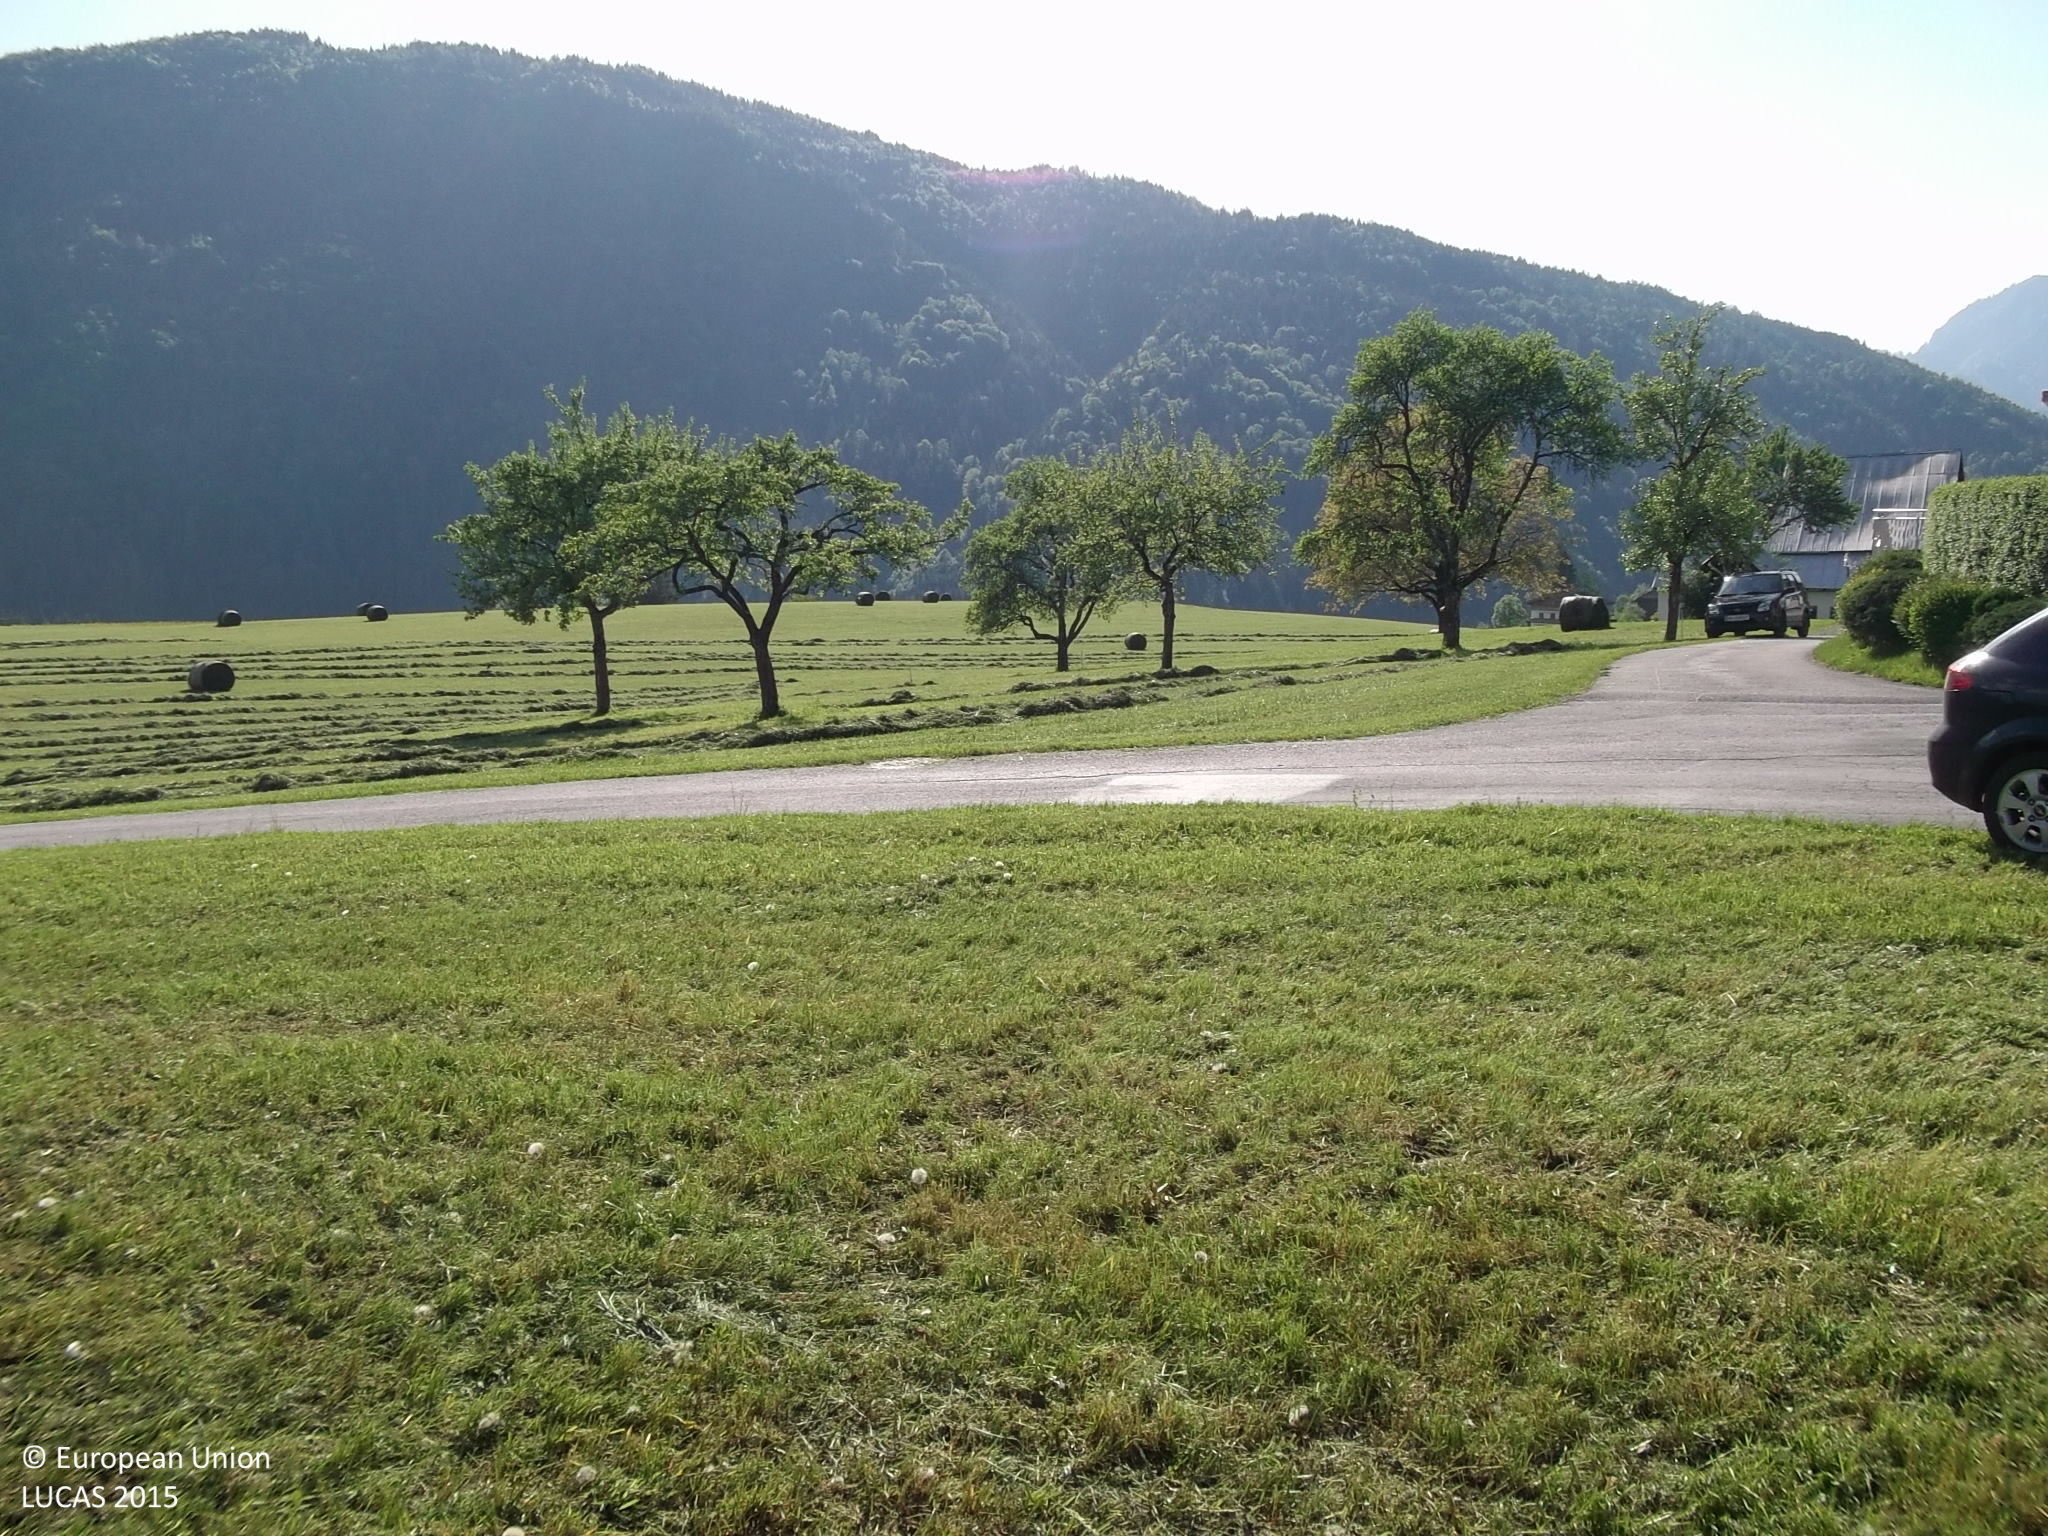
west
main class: Grassland
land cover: Grassland without tree/shrub cover
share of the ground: > 75 %
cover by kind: herbaceous plants 100 %
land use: Agriculture (excluding fallow land and kitchen gardens)
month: May
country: AT
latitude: 47.5787
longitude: 13.3355
